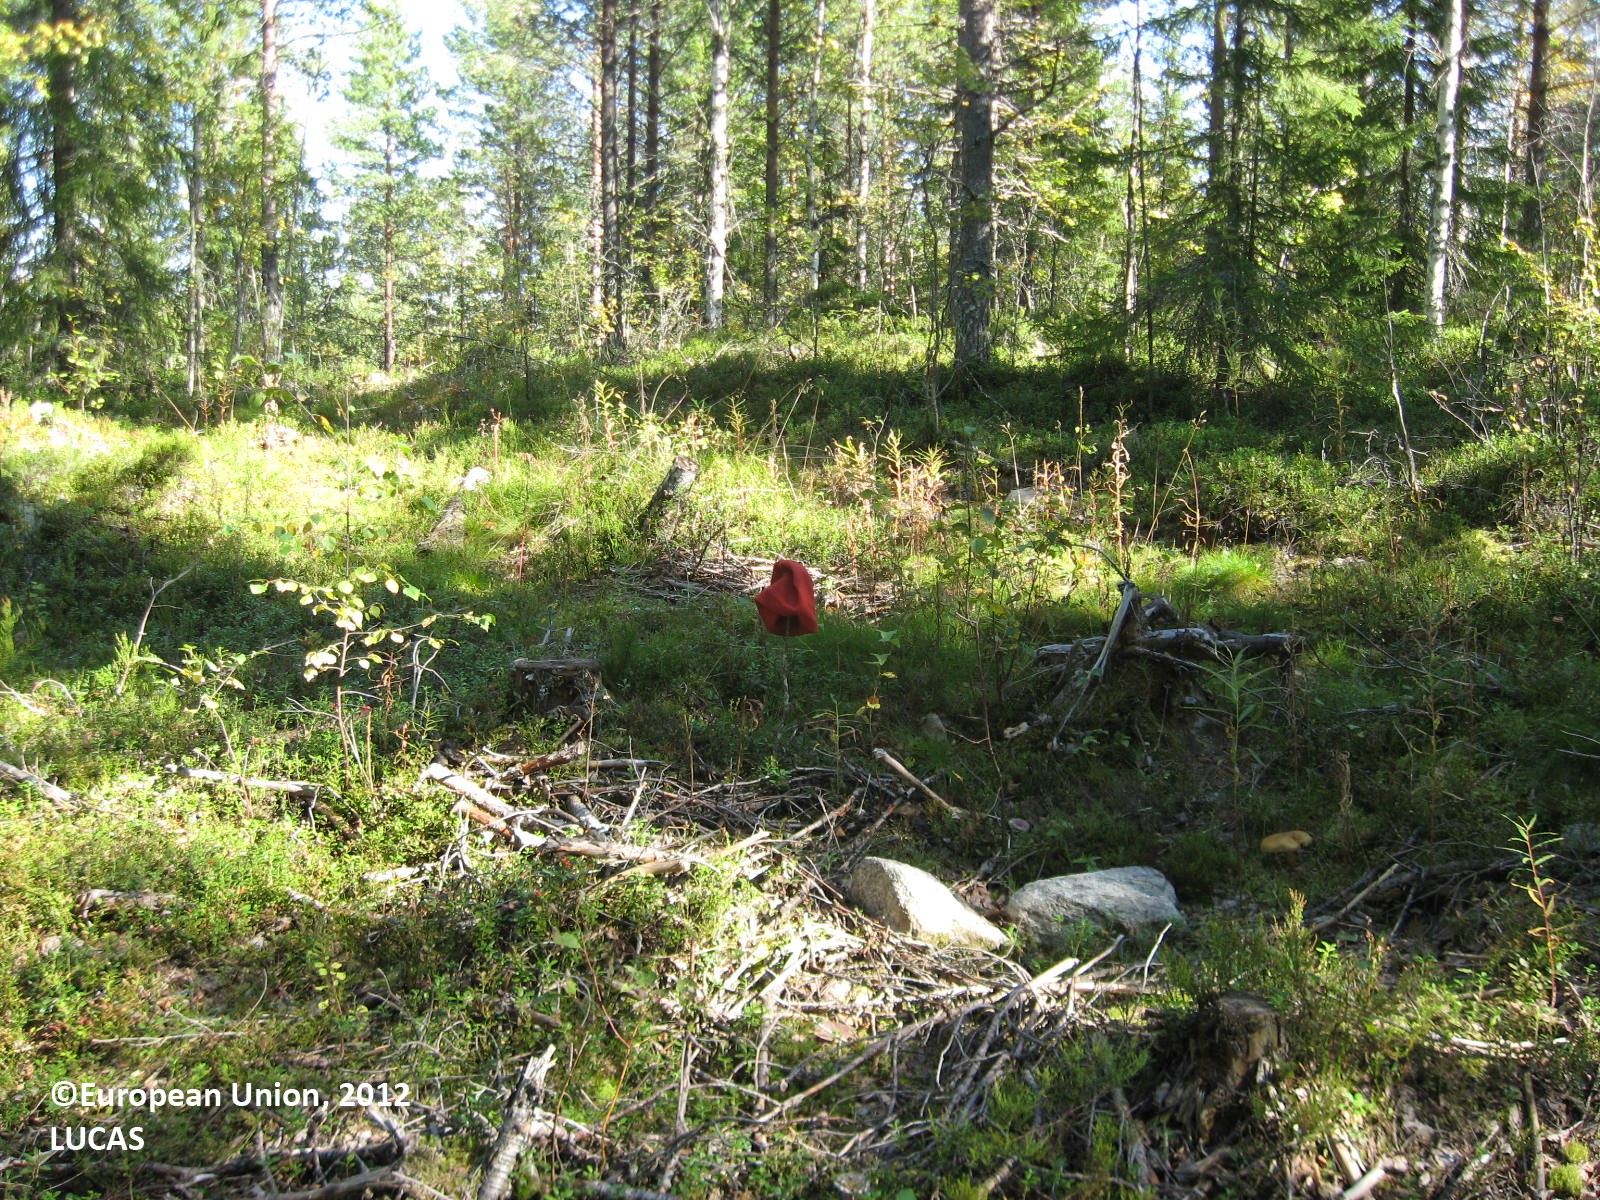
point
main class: Woodland
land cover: Pine dominated mixed woodland
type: boreal forest
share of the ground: > 75 %
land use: Forestry
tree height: > 5 m
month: August
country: FI
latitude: 63.8378
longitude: 29.3877
